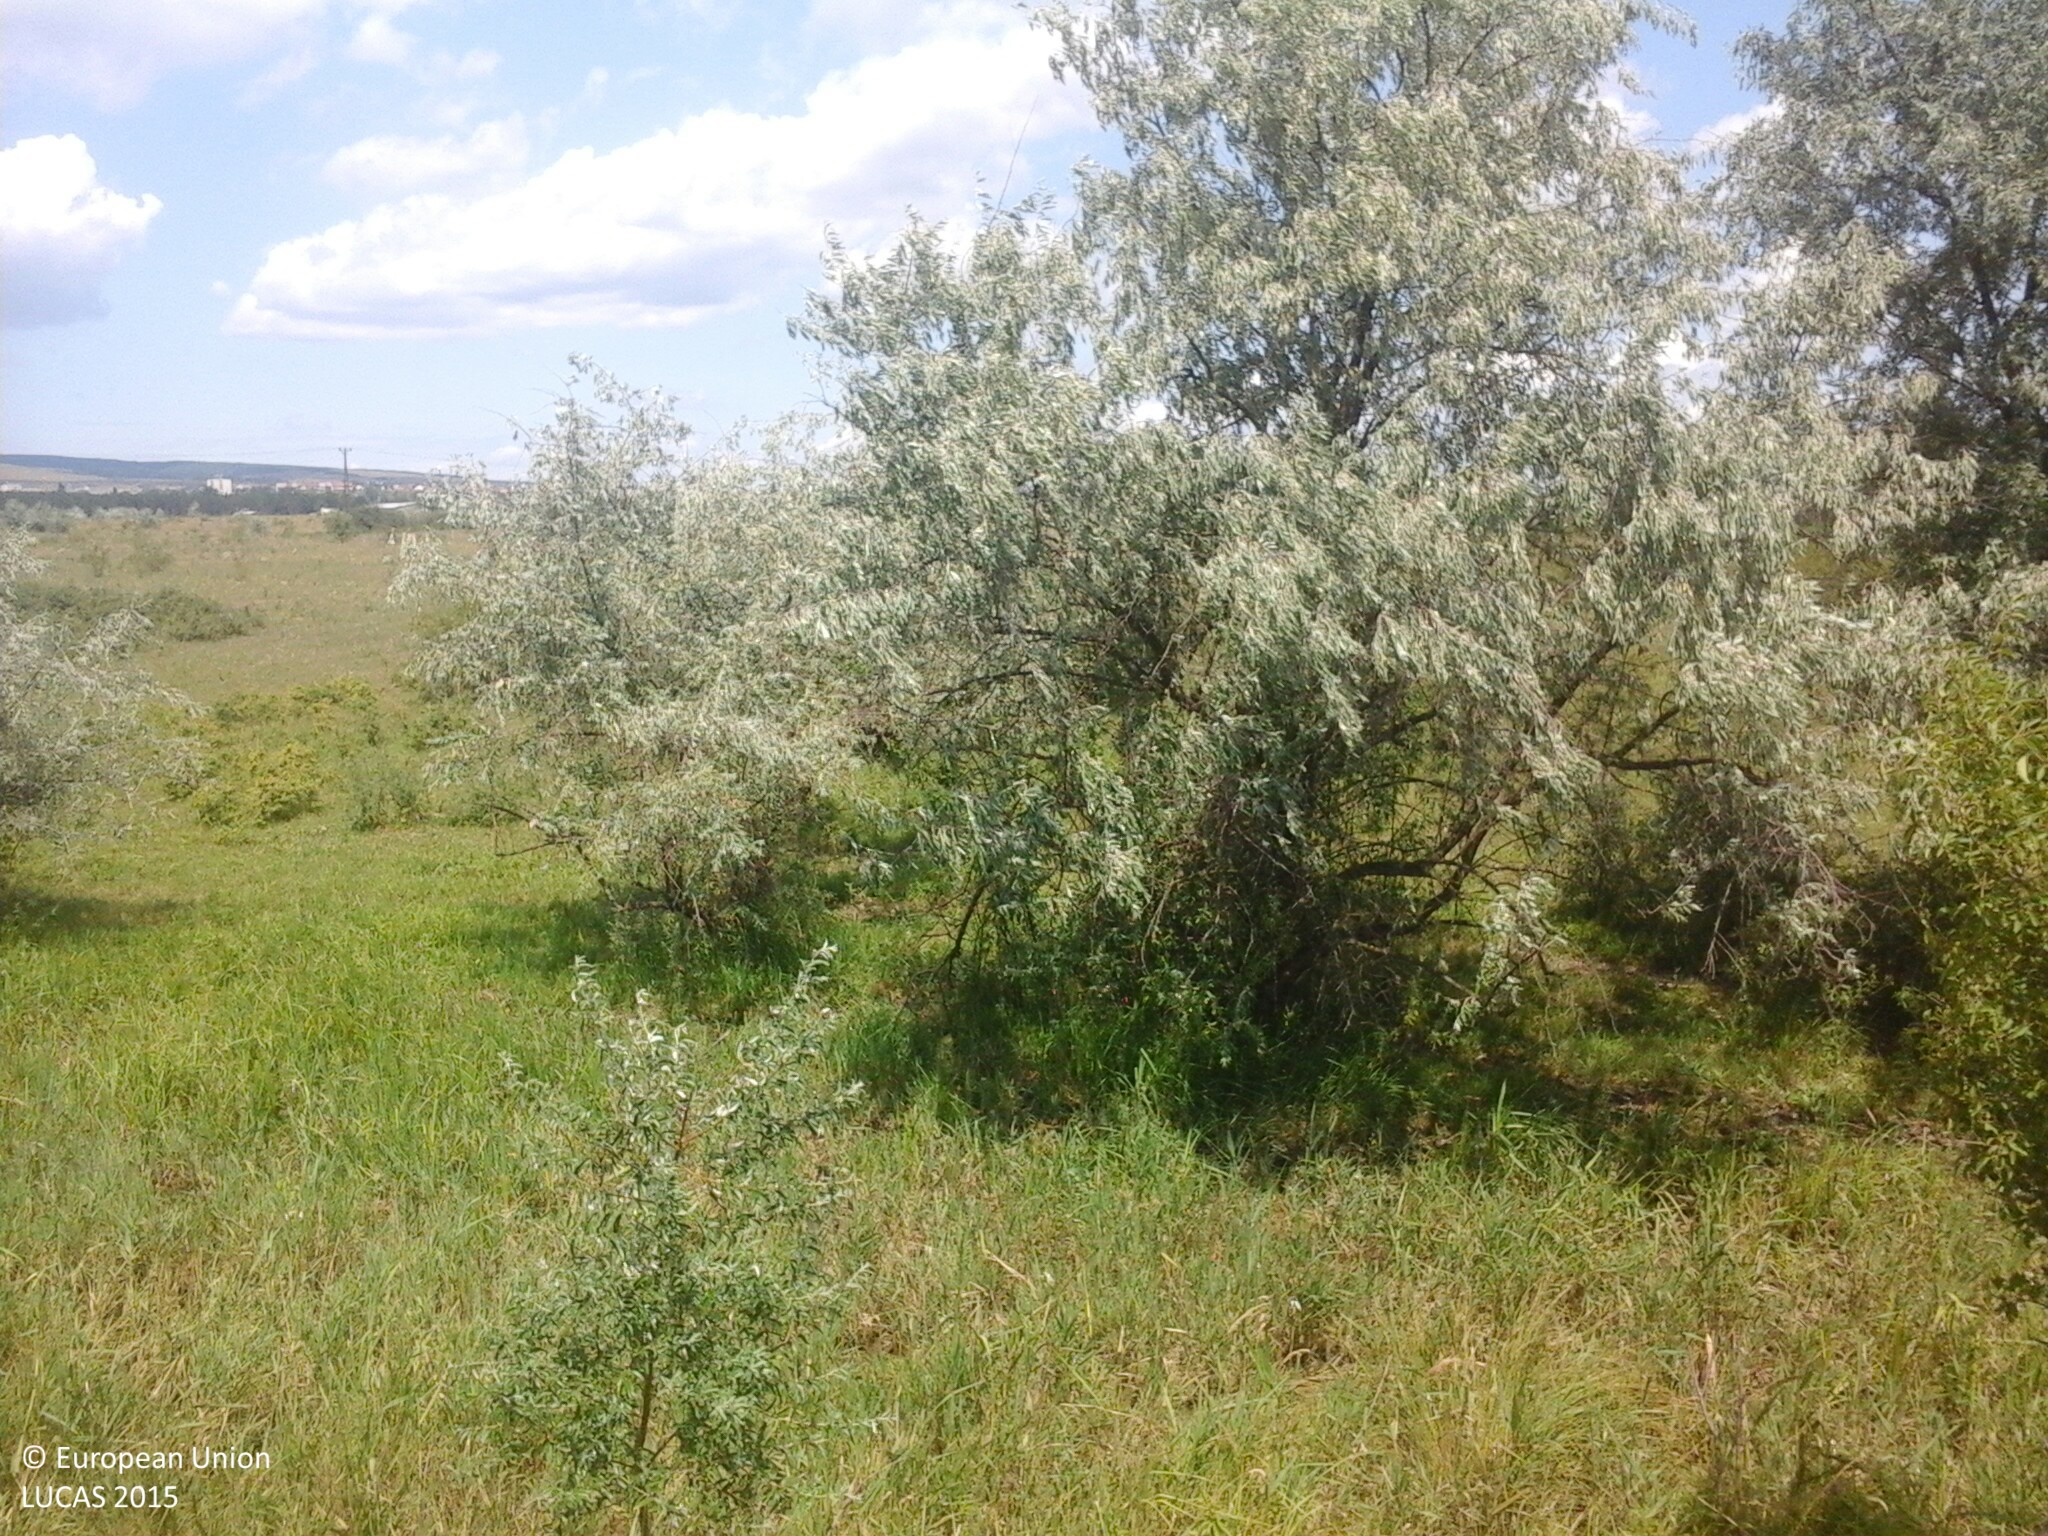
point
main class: Grassland
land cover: Grassland with sparse tree/shrub cover
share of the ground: > 75 %
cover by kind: herbaceous plants 90 %, broadleaved forest trees 5 %, shrubs 5 %
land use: Agriculture (excluding fallow land and kitchen gardens)
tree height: > 5 m
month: July
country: HU
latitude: 47.1797
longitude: 18.1521
